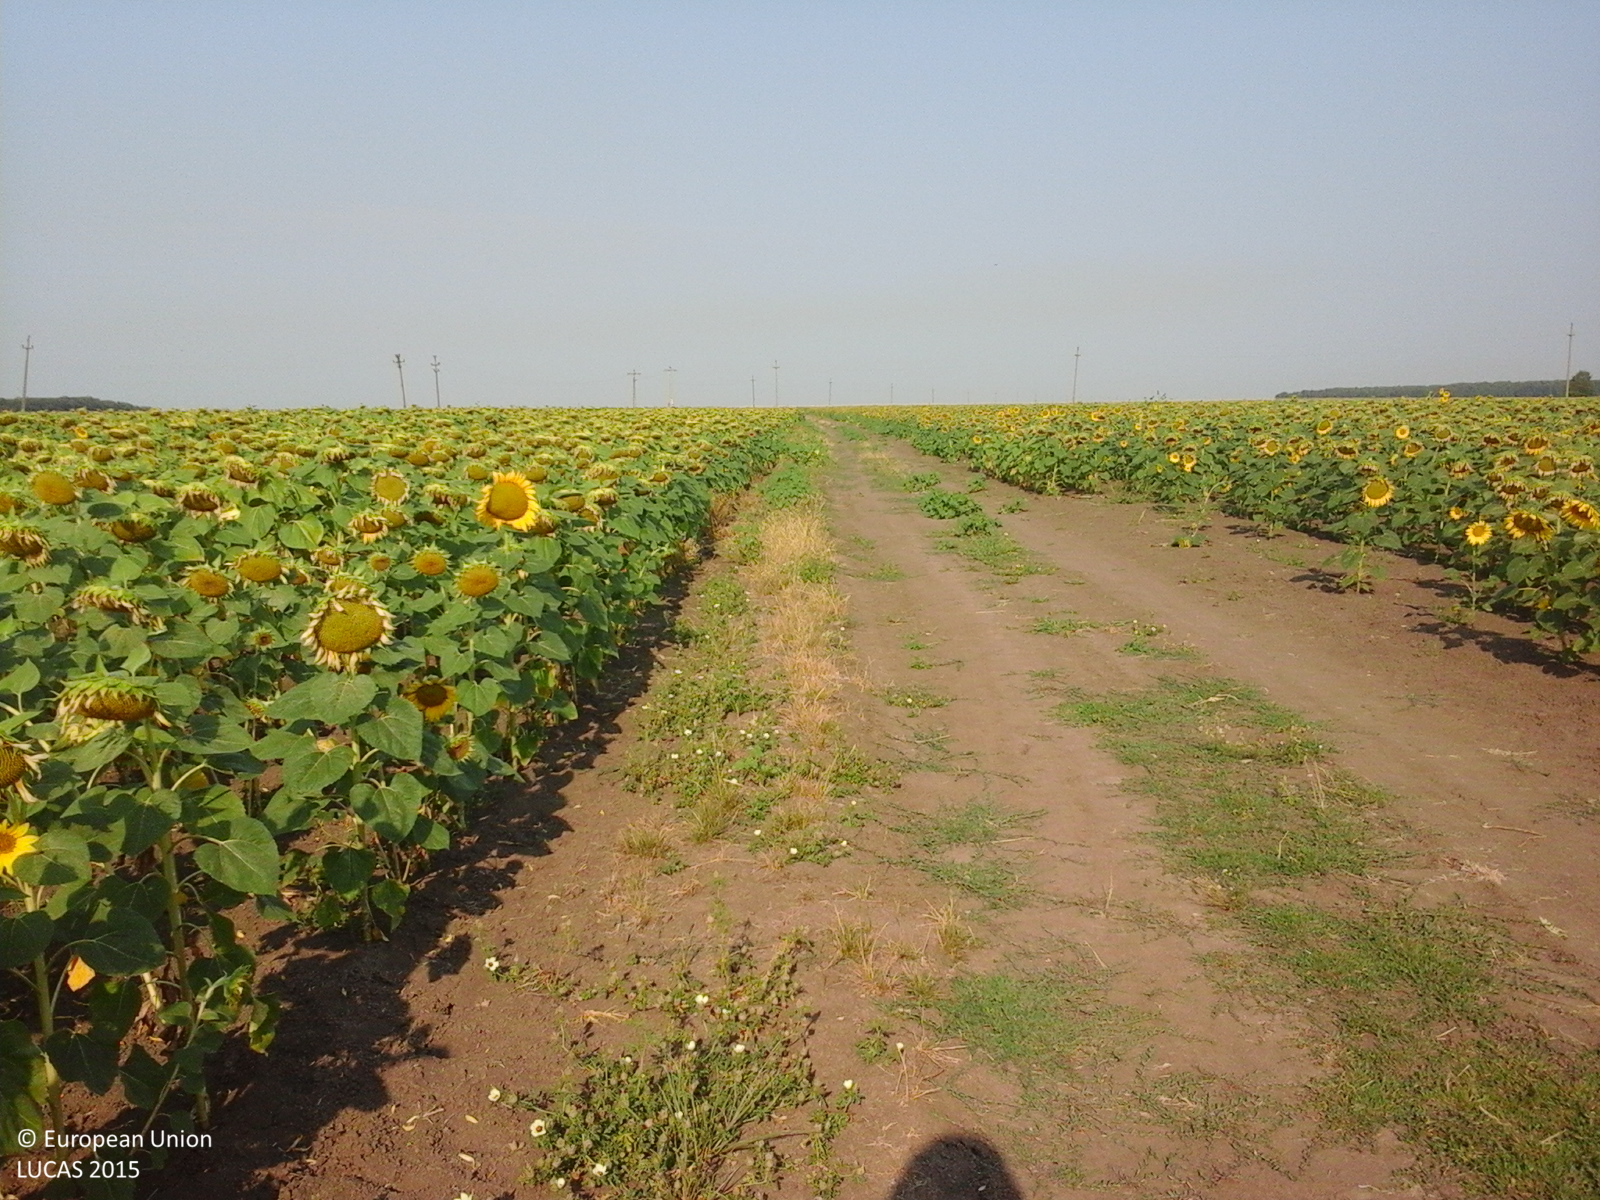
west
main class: Cropland
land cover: Sunflower
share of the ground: > 75 %
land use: Agriculture (excluding fallow land and kitchen gardens)
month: August
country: RO
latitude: 44.4244
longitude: 23.2756
